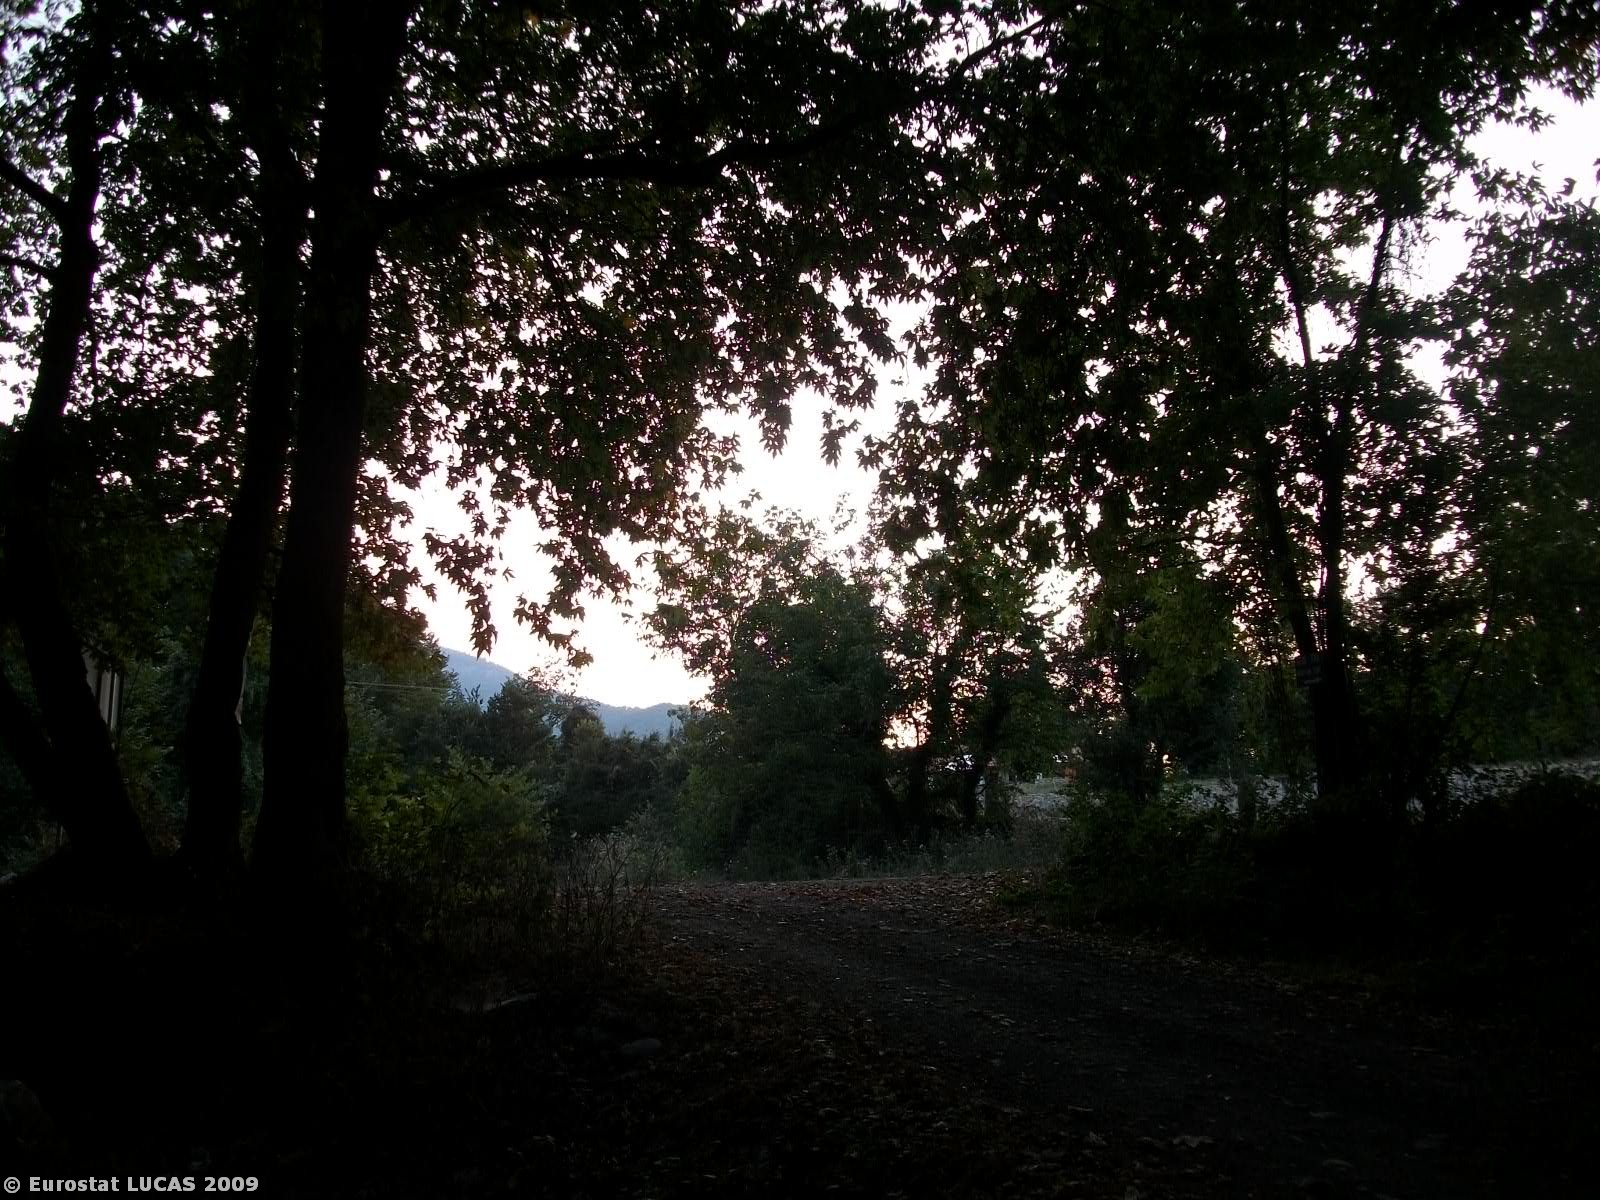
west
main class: Woodland
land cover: Broadleaved woodland
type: floodplain forest
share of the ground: > 75 %
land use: Unused
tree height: > 5 m
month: August
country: GR
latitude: 39.4116
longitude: 21.6064
